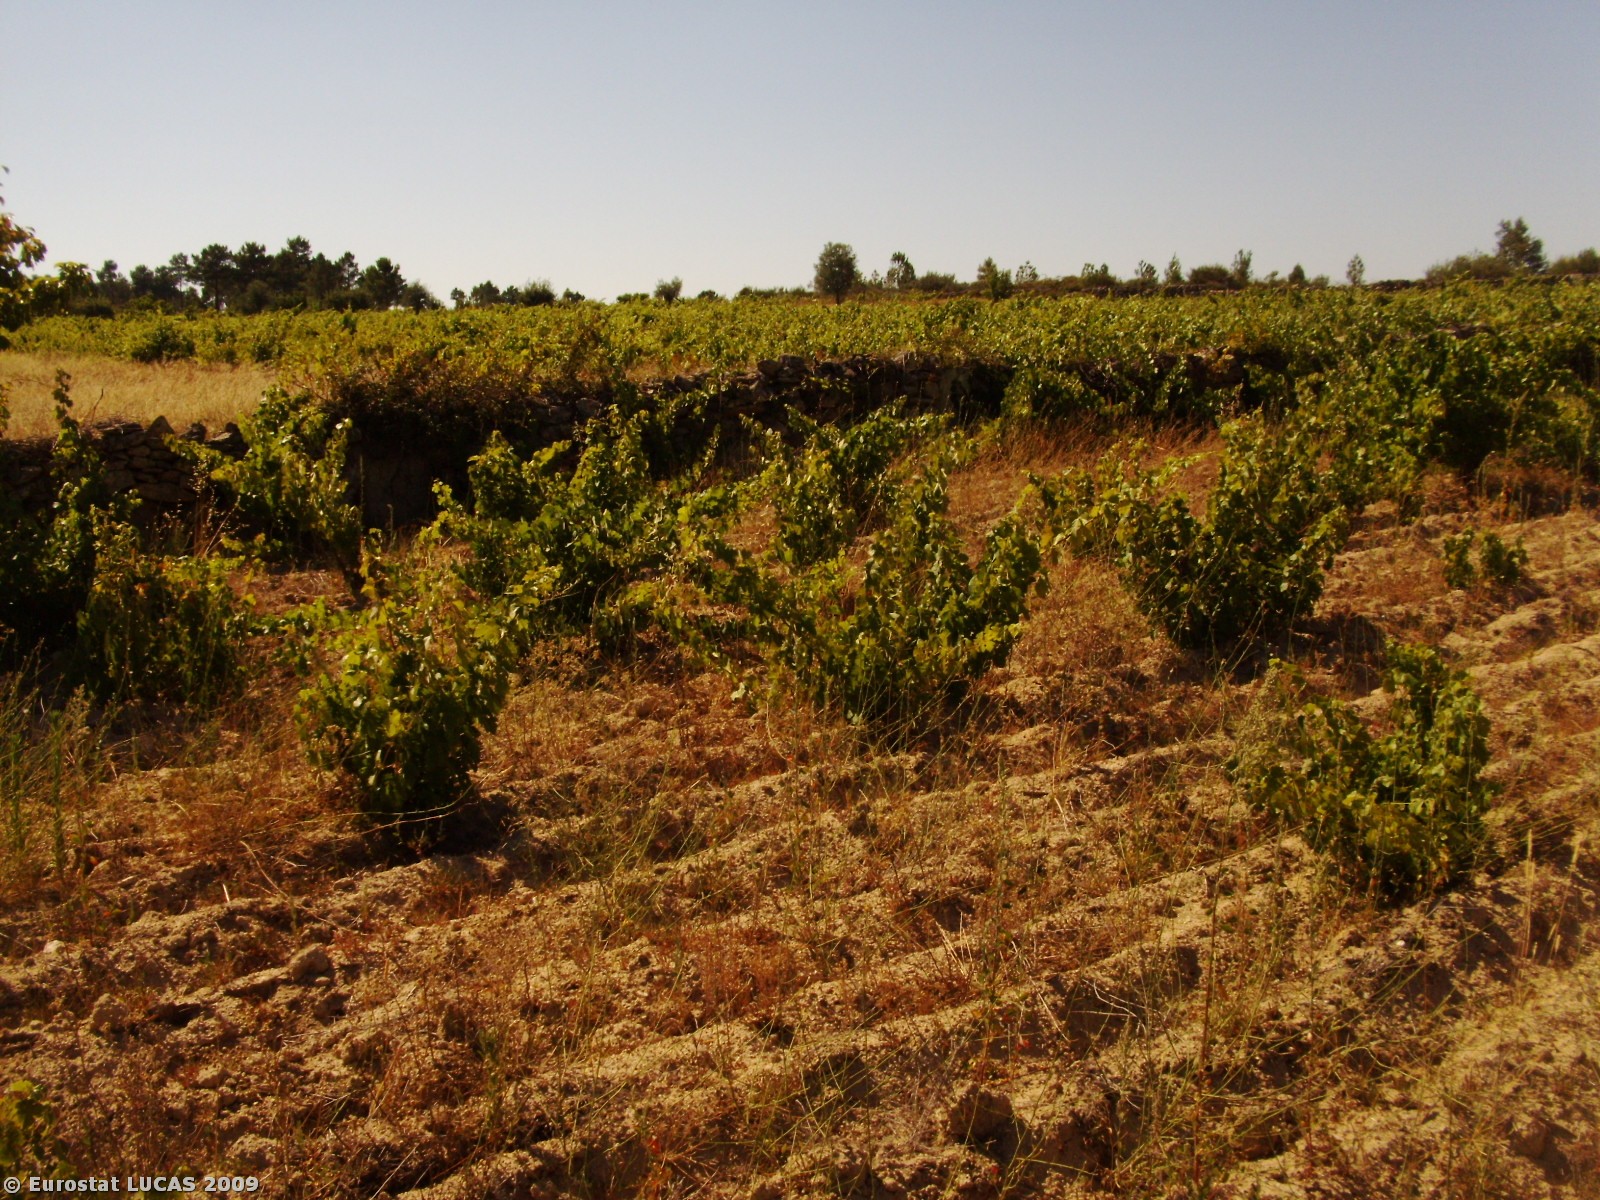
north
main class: Cropland
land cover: Vineyards
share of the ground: 50 - 75 %
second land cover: Bare land
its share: 25 - 50 %
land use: Agriculture (excluding fallow land and kitchen gardens)
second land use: Fallow land
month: July
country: PT
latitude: 40.5029
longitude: -7.0089
